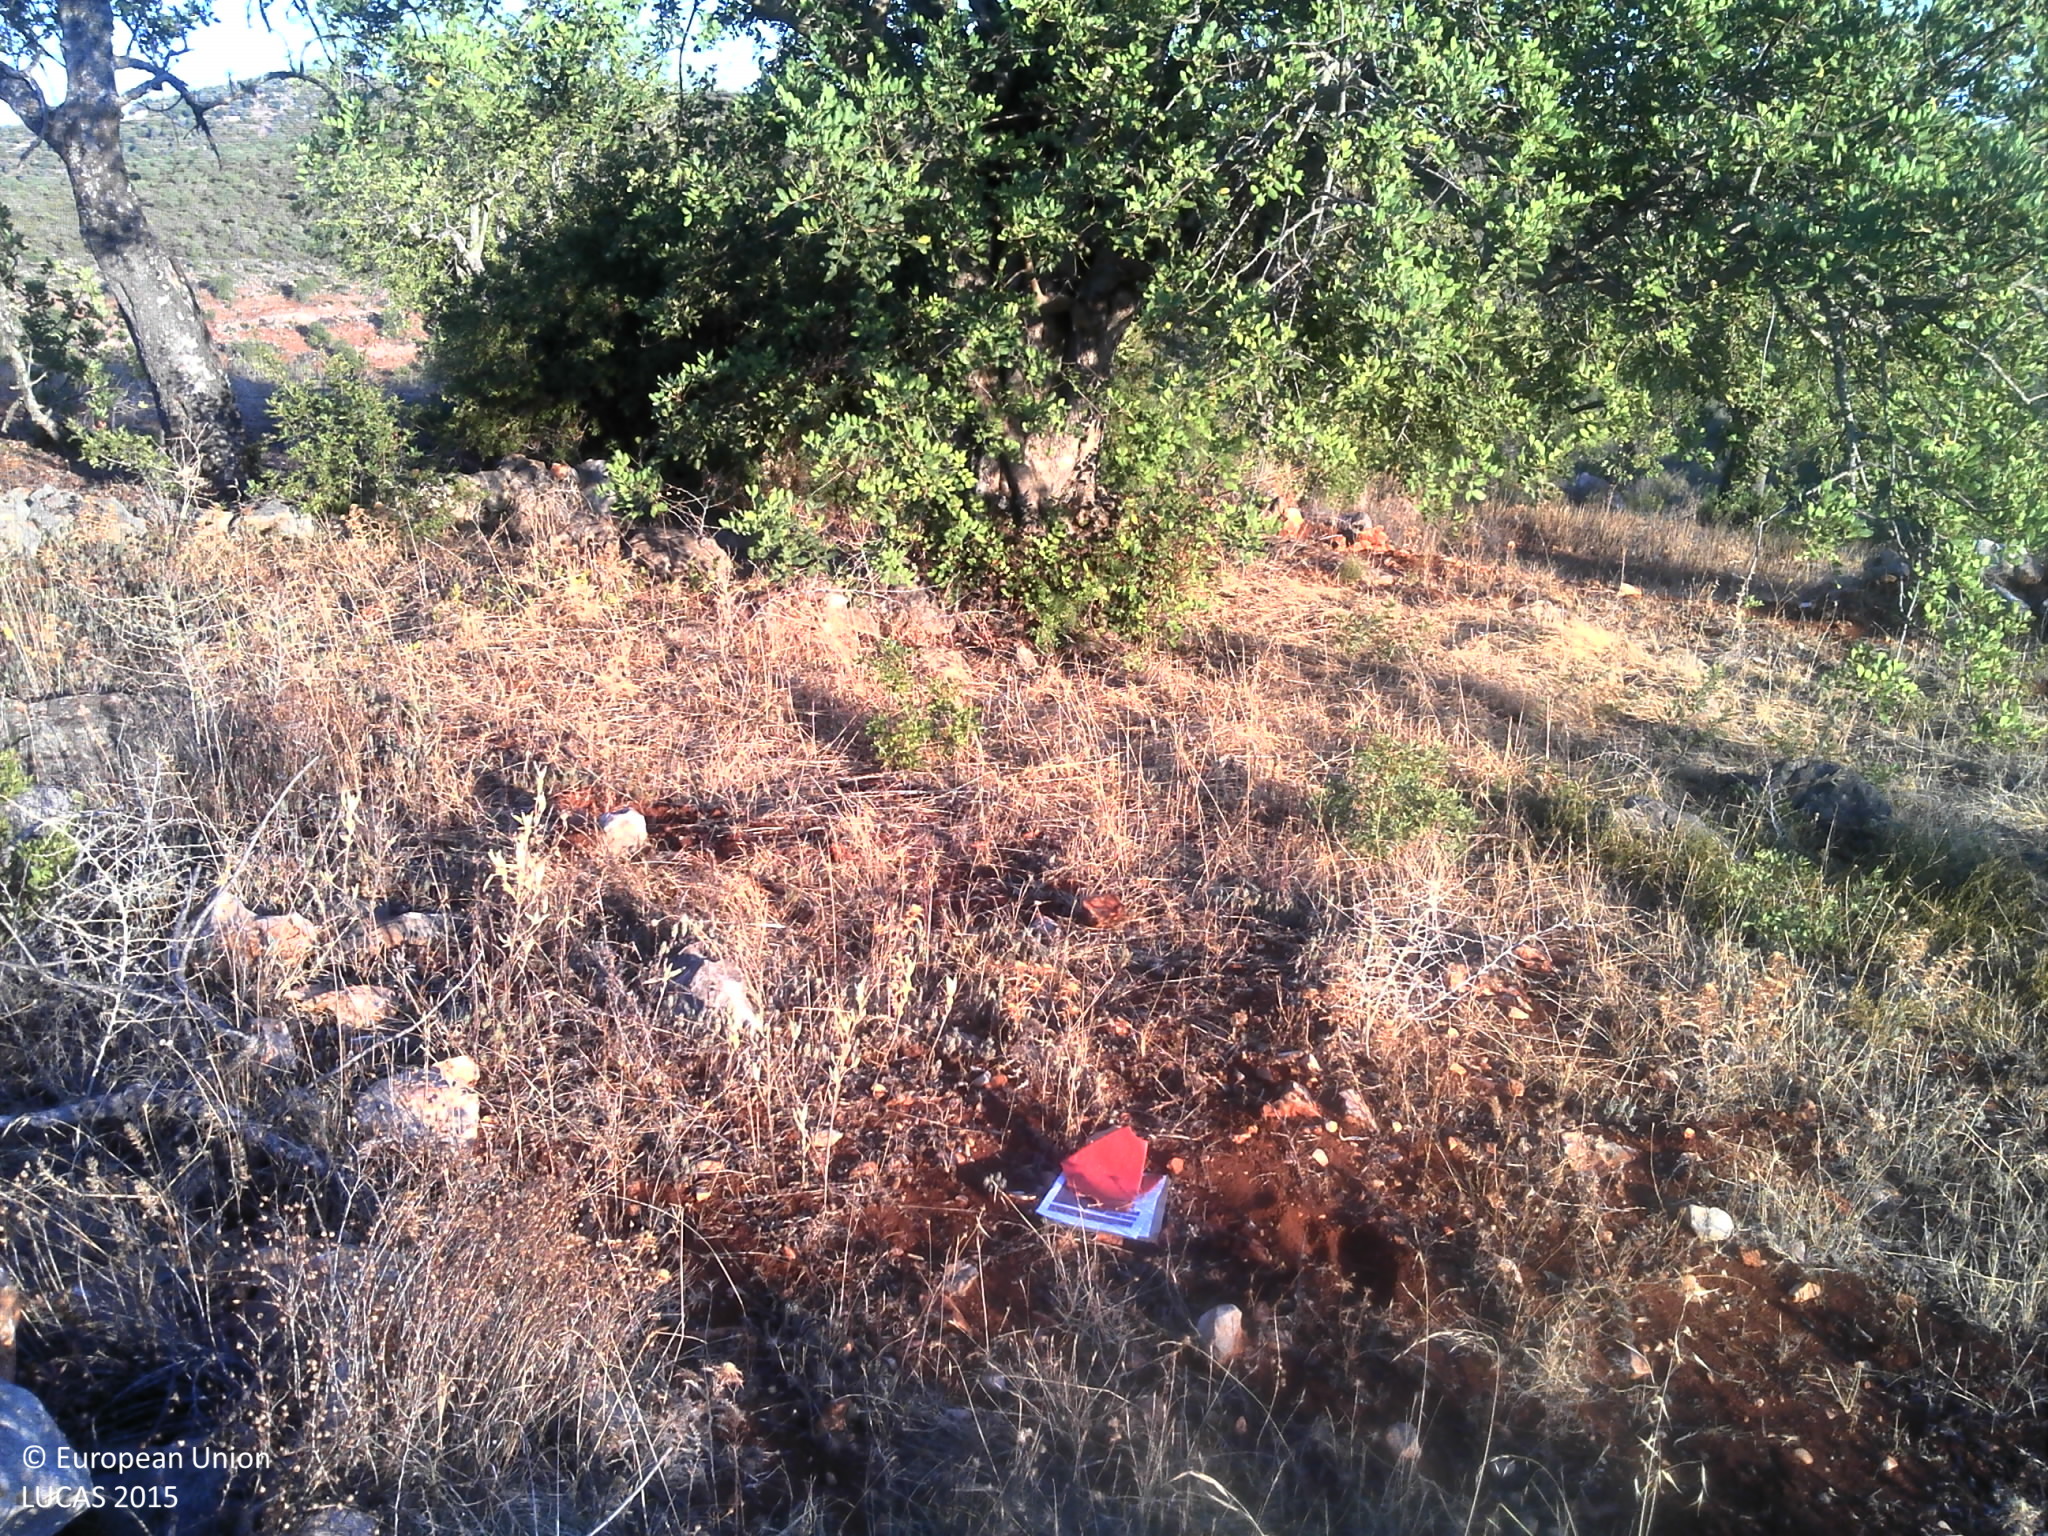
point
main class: Cropland
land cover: Permanent industrial crops
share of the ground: 25 - 50 %
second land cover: Spontaneously vegetated surfaces
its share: 25 - 50 %
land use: Agriculture (excluding fallow land and kitchen gardens)
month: September
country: PT
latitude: 37.2081
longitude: -8.1475
